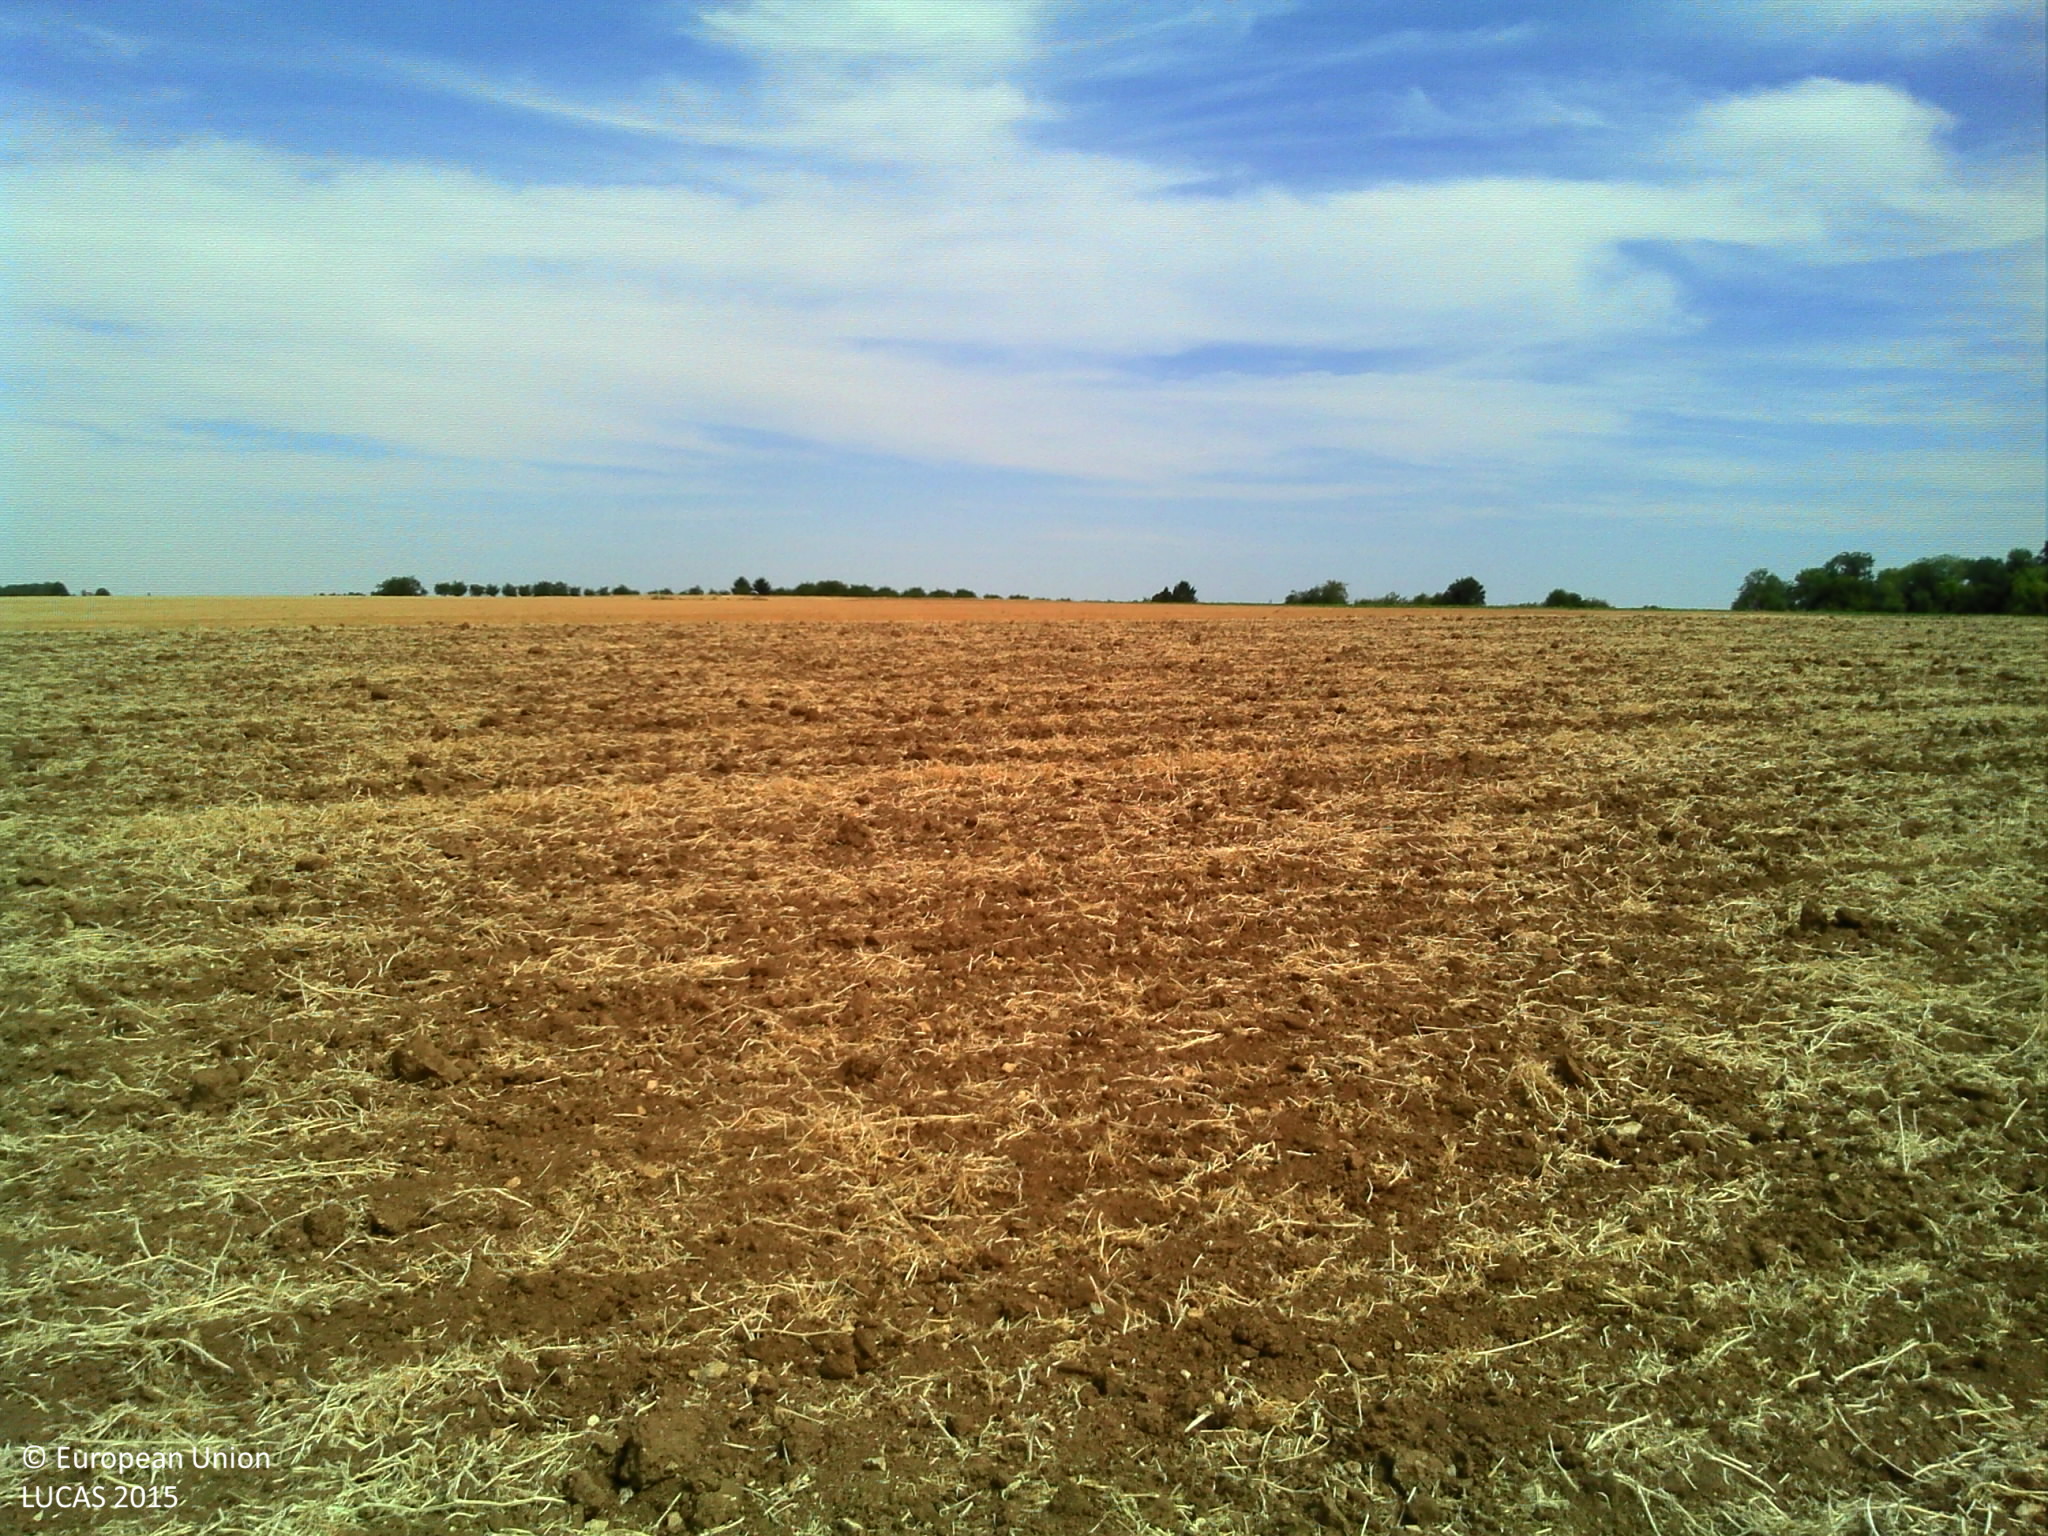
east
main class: Cropland
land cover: Dry pulses
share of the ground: > 75 %
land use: Agriculture (excluding fallow land and kitchen gardens)
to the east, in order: Dry pulses; Tracks; Sugar beet
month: August
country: FR
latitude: 48.2186
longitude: 2.4660
